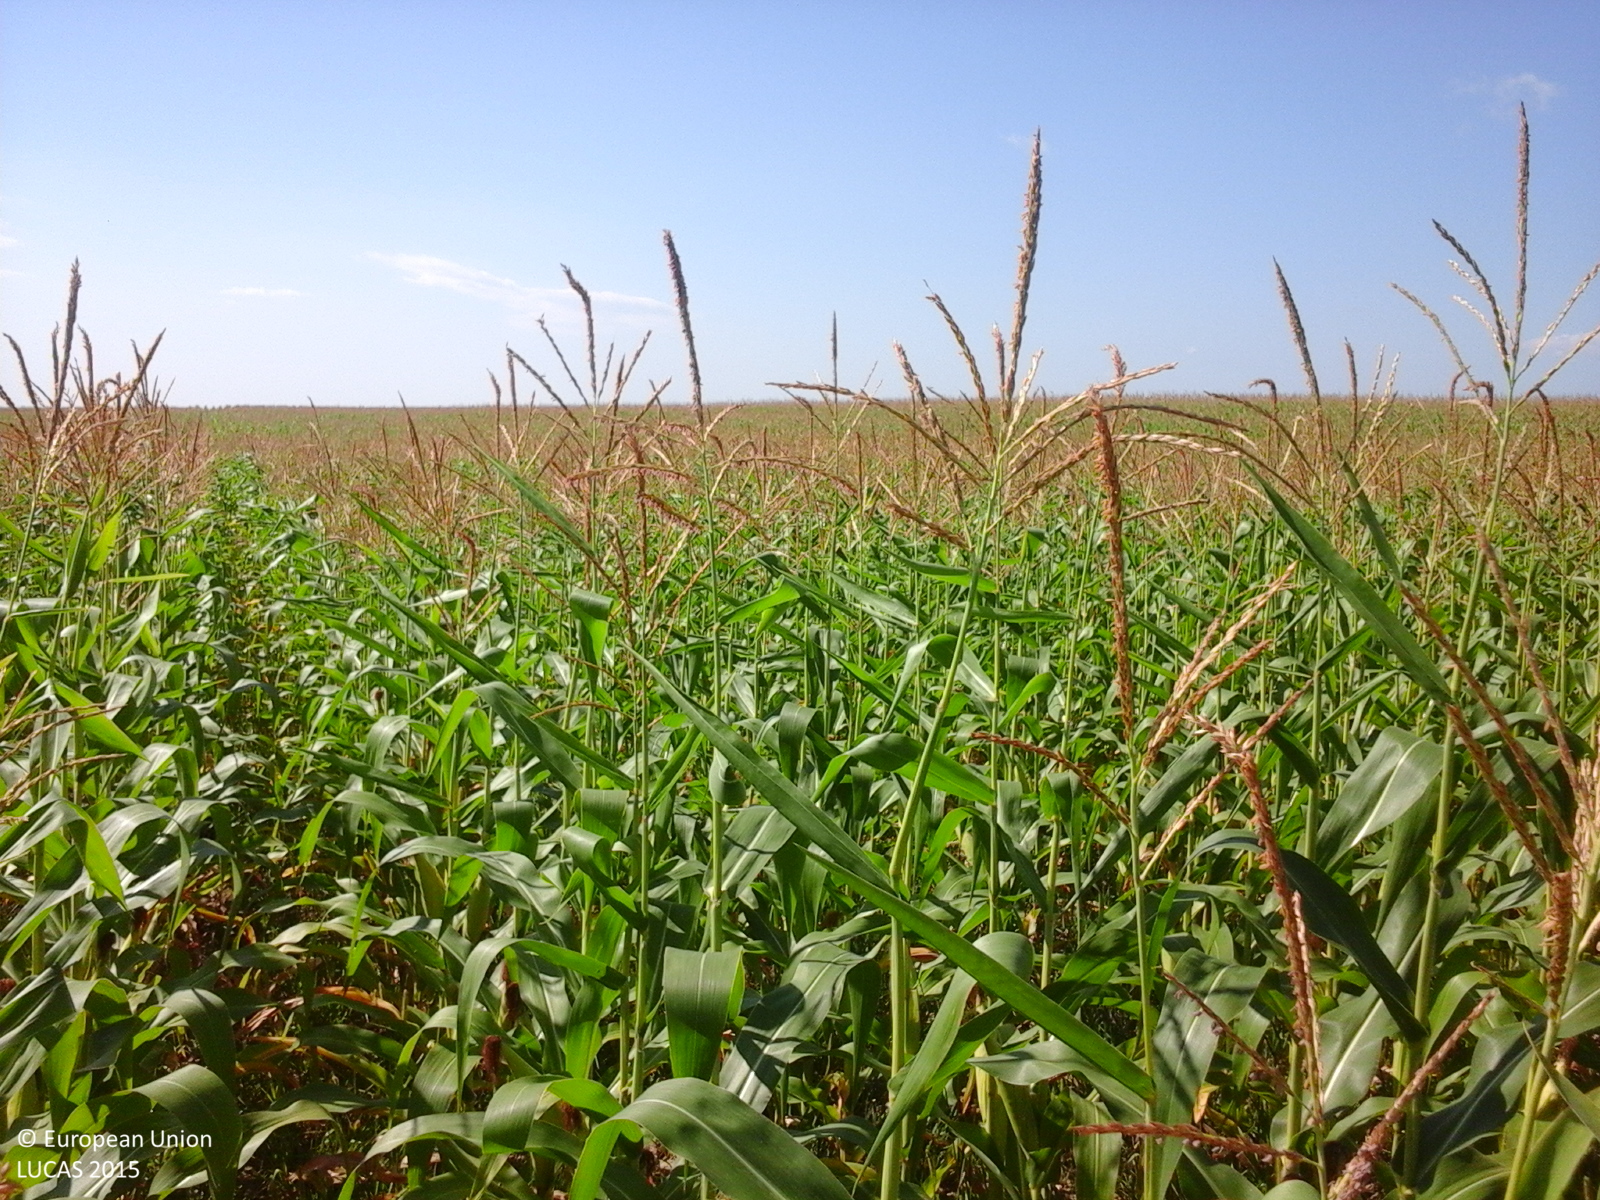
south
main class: Cropland
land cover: Maize
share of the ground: > 75 %
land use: Agriculture (excluding fallow land and kitchen gardens)
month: July
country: RO
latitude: 46.0191
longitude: 27.2664
